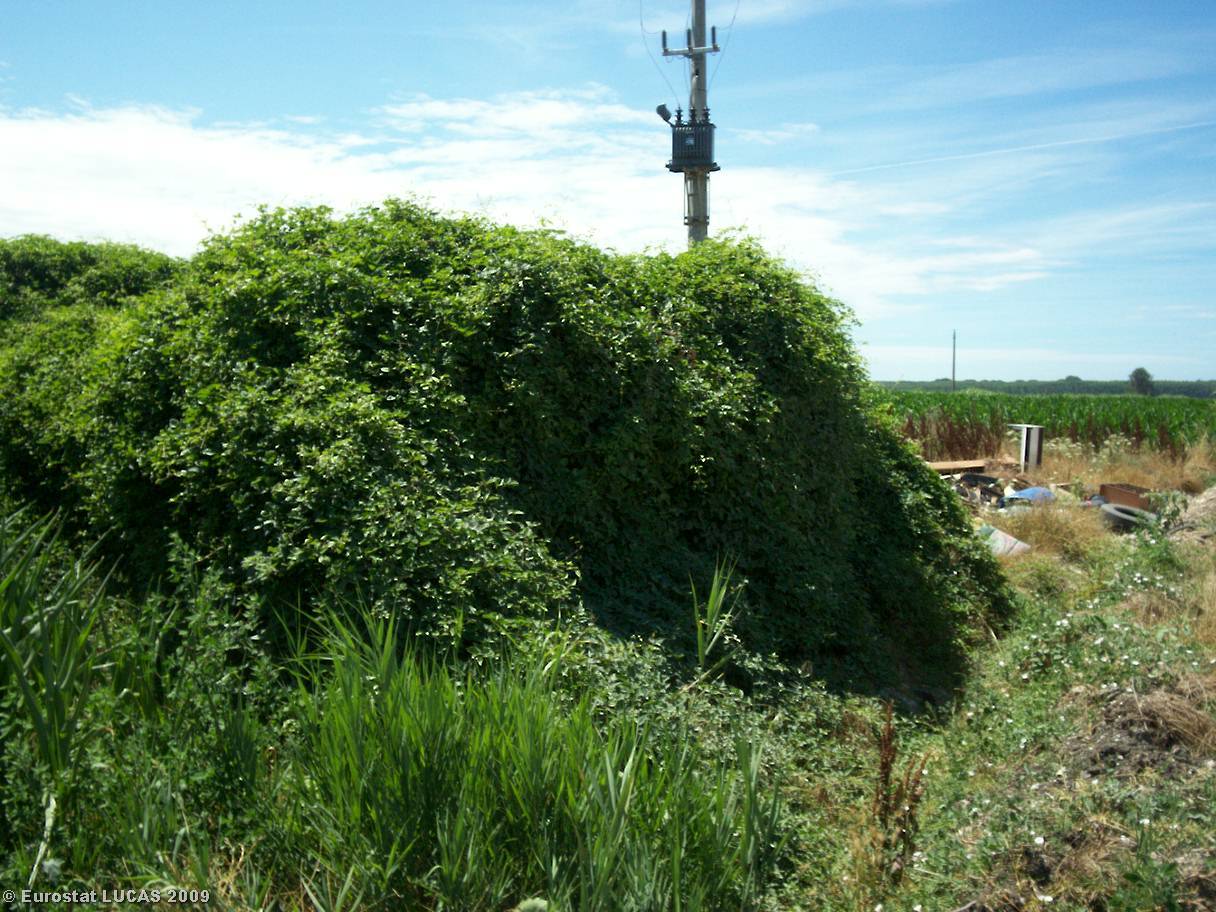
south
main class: Cropland
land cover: Maize
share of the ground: > 75 %
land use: Agriculture (excluding fallow land and kitchen gardens)
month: June
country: IT
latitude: 43.8088
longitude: 10.3347
